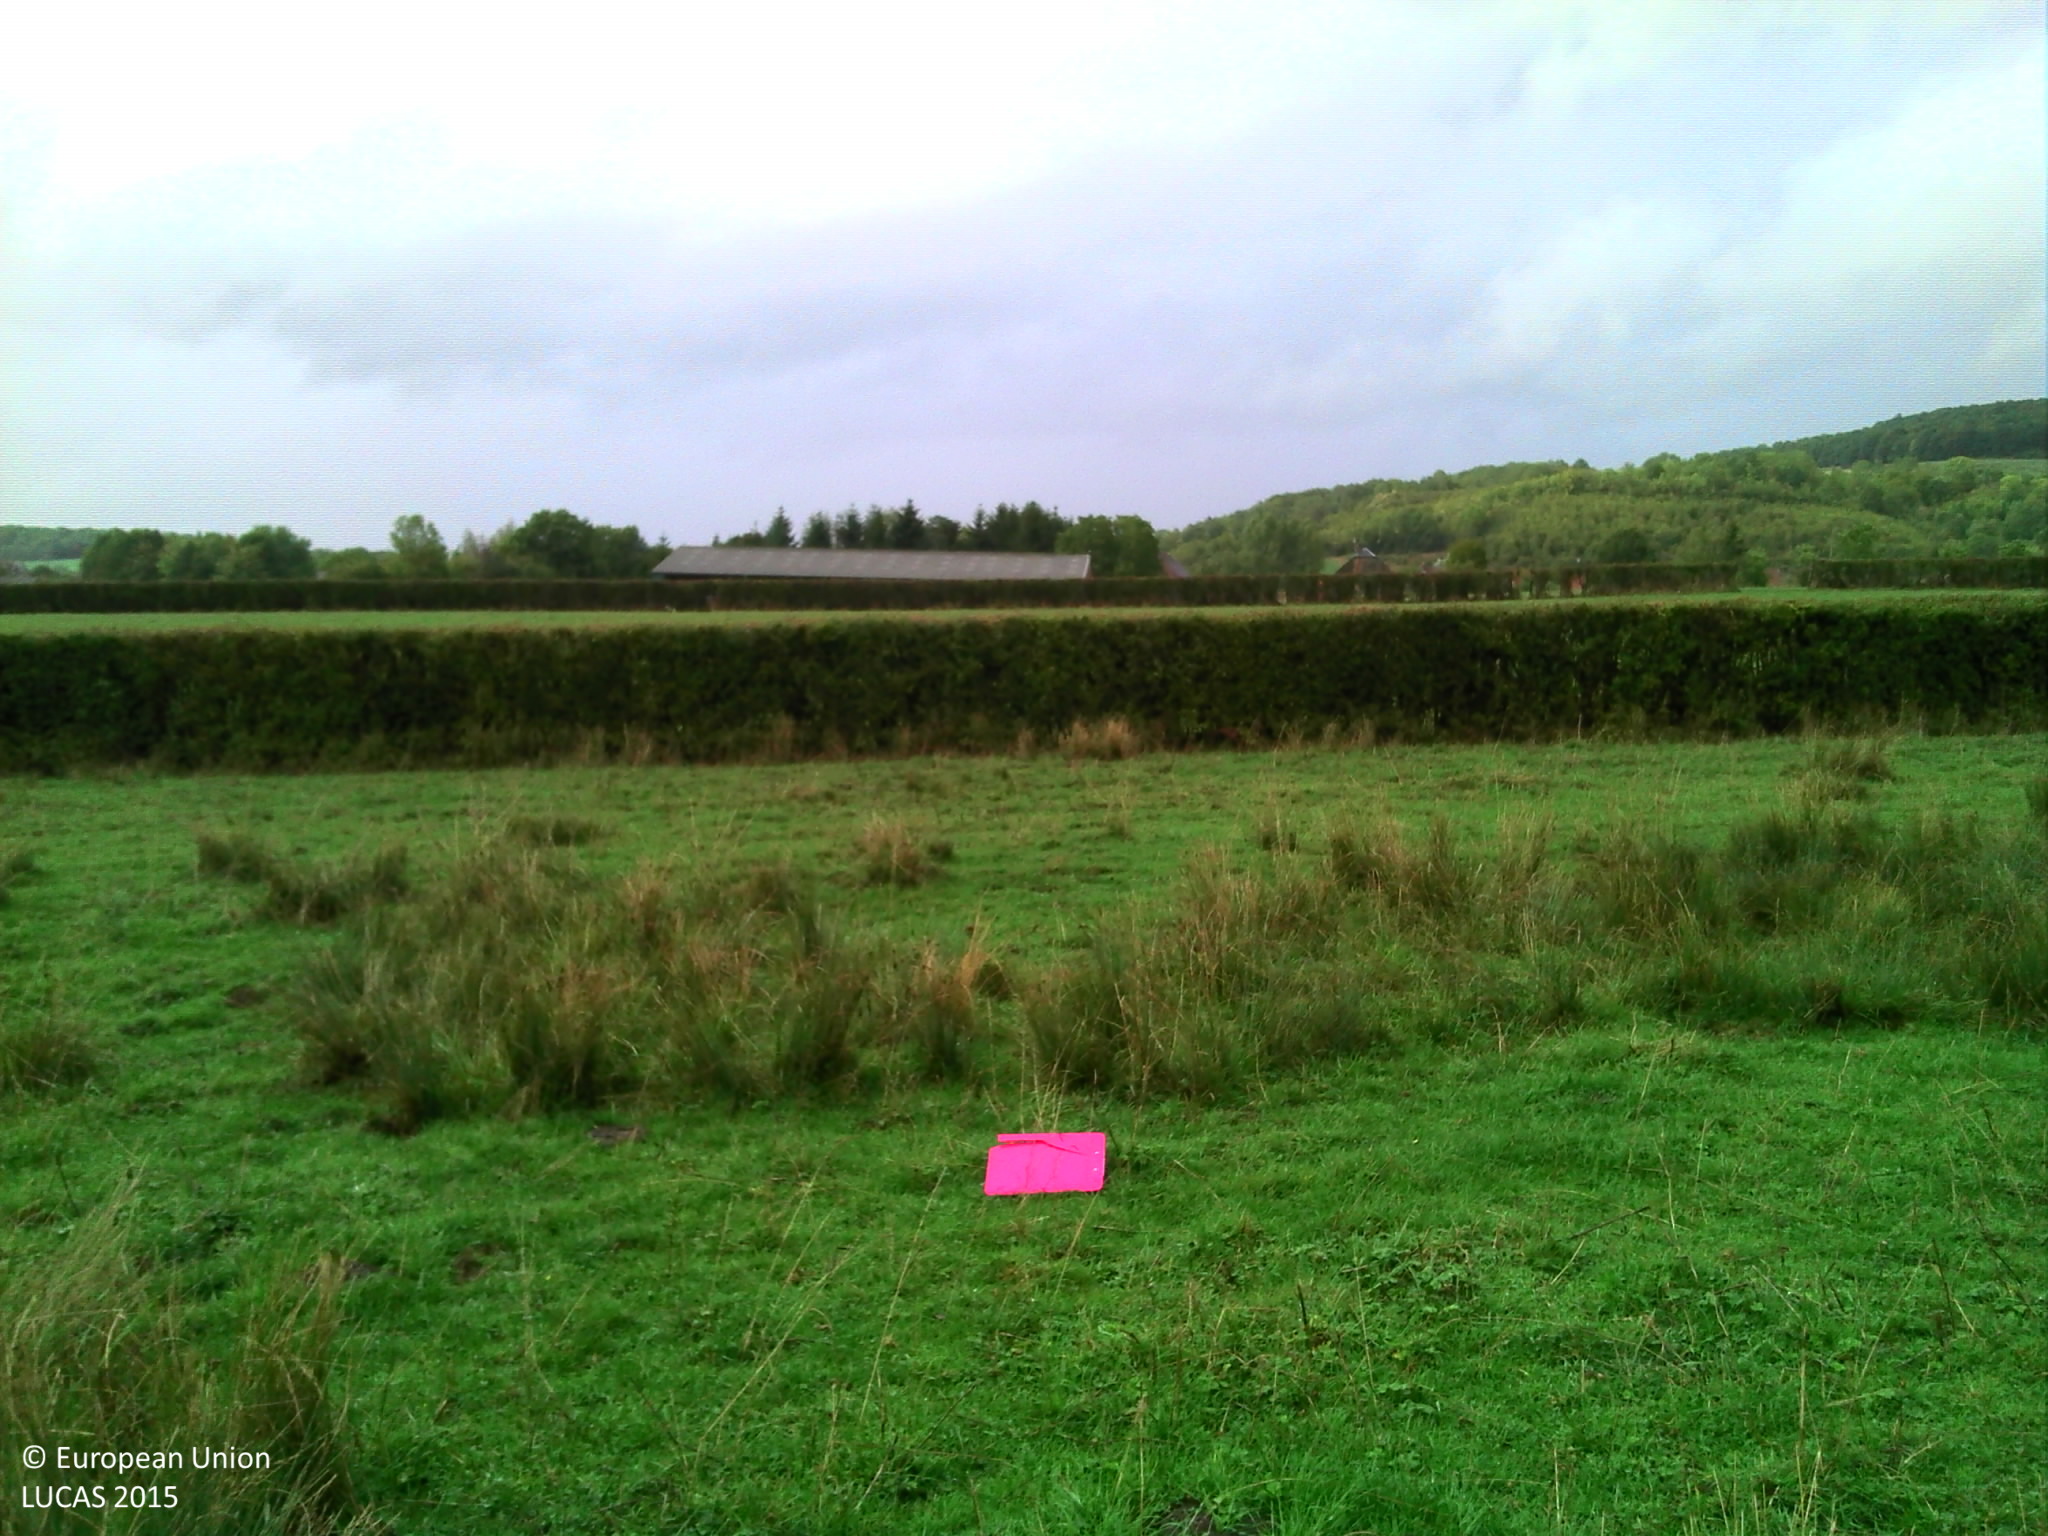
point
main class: Grassland
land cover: Grassland without tree/shrub cover
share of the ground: > 75 %
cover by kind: herbaceous plants 100 %
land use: Agriculture (excluding fallow land and kitchen gardens)
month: September
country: FR
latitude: 47.3043
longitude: 4.3781
